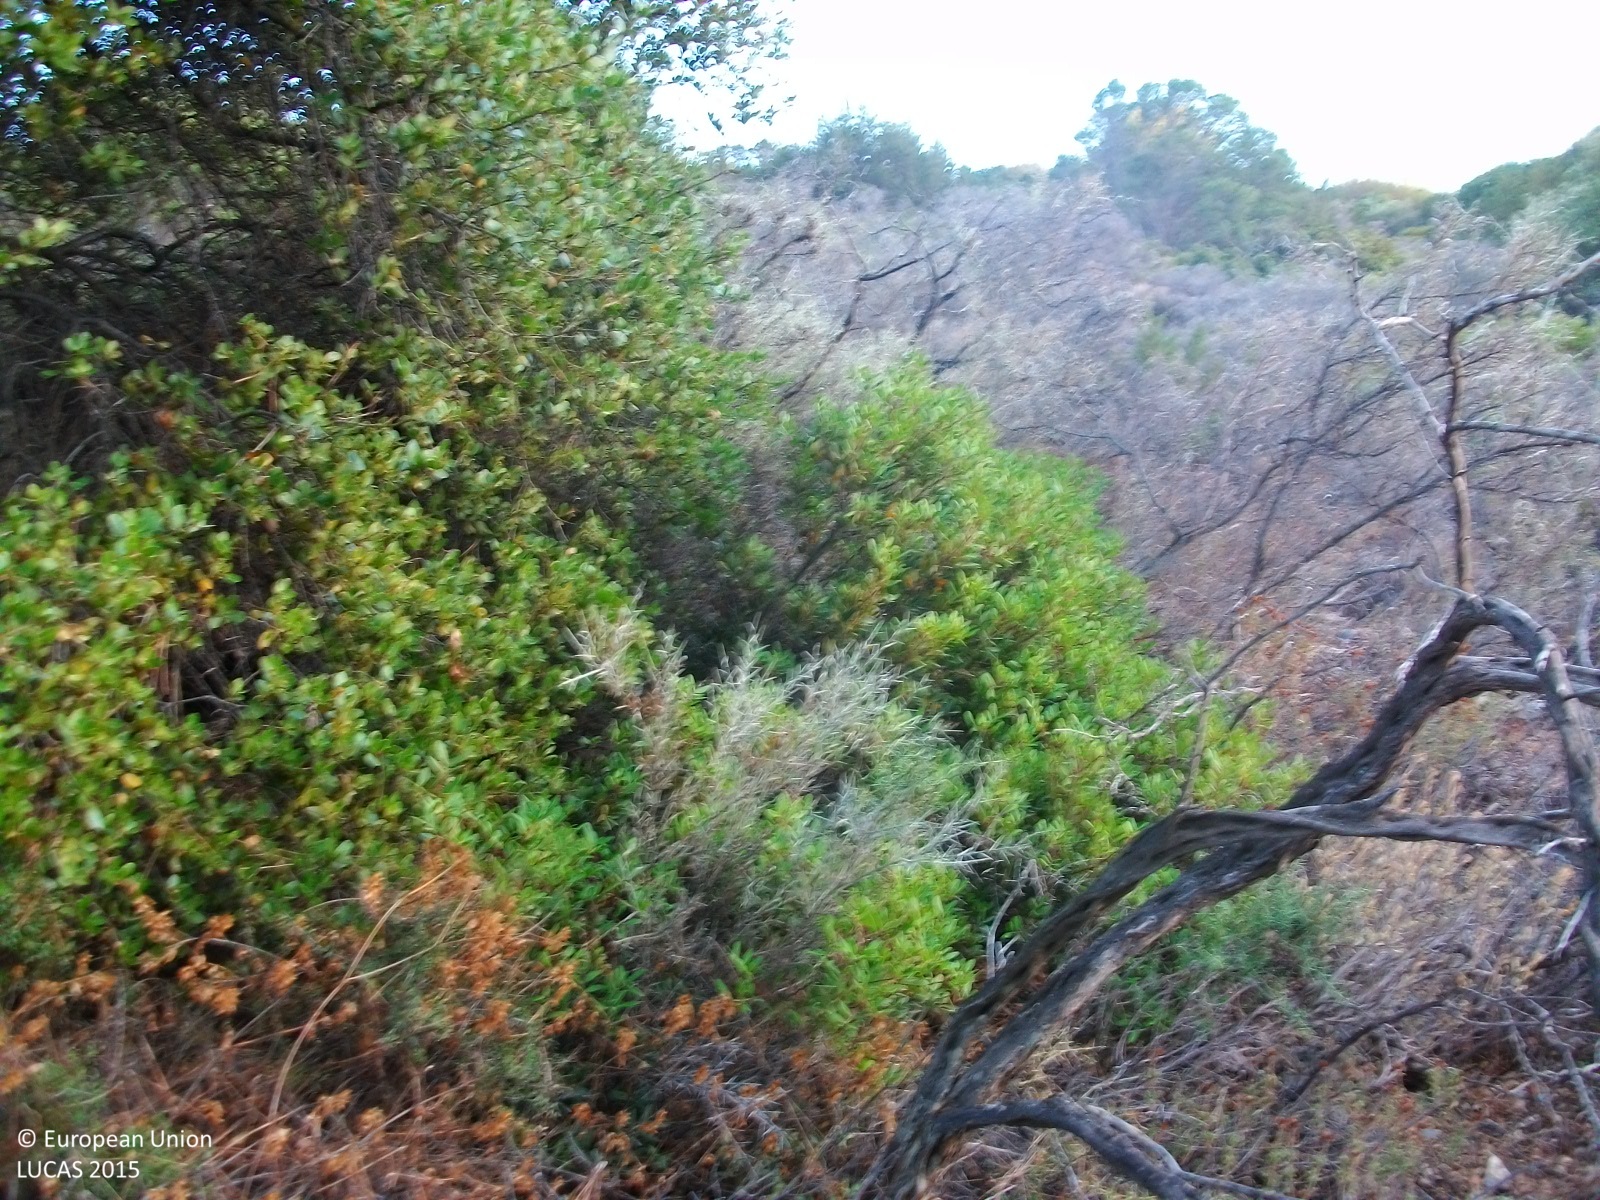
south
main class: Woodland
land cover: Pine dominated coniferous woodland
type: coniferous forest of the mediterranean region
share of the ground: 10 - 25 %
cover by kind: shrubs 70 %, coniferous forest trees 20 %, herbaceous plants 10 %
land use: Semi-natural and natural areas not in use
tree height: < 5 m
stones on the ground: 10 - 25 %
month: August
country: GR
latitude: 35.1139
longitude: 25.7629
